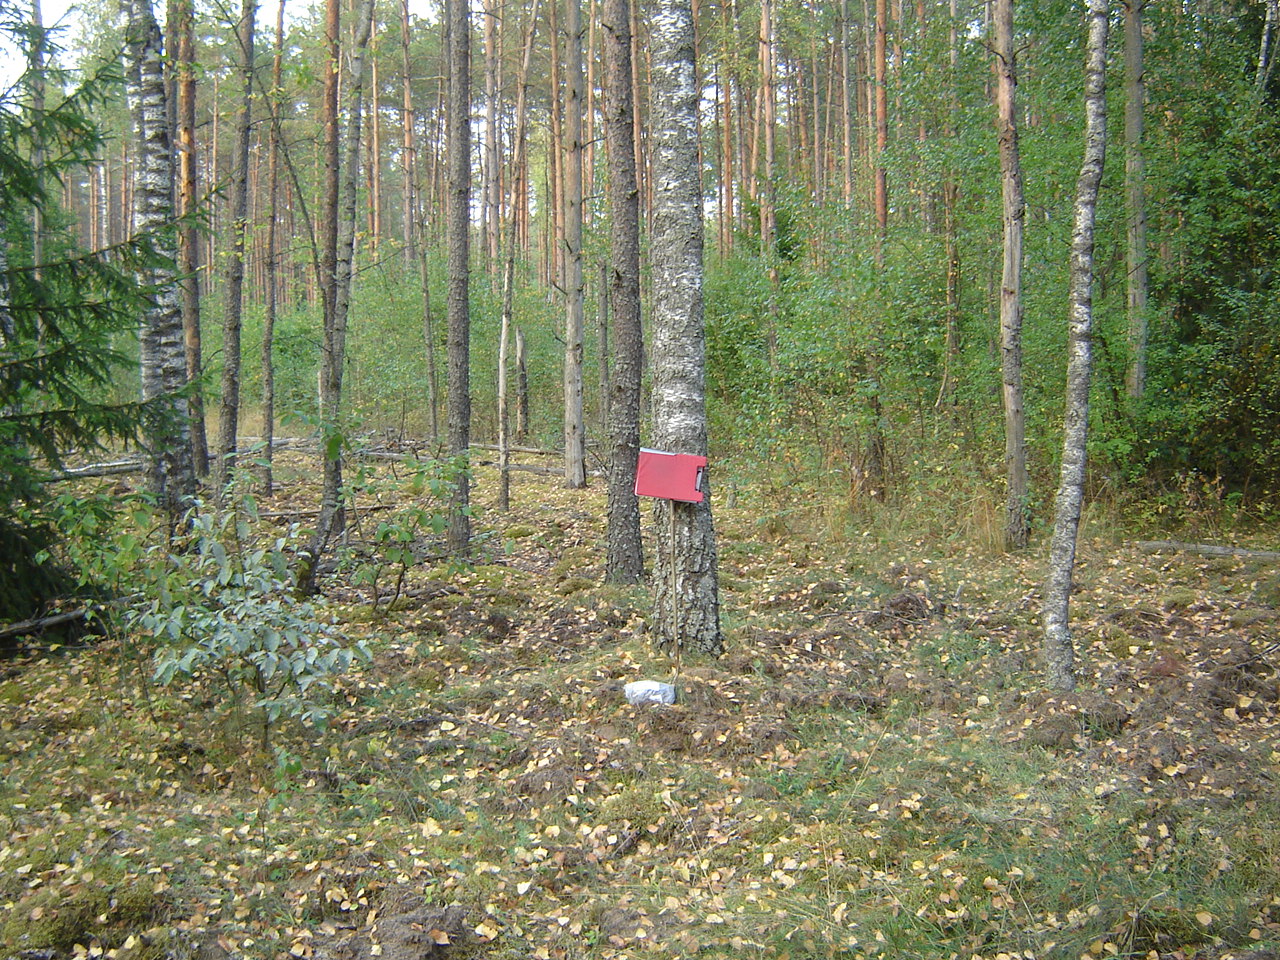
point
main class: Woodland
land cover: Pine dominated mixed woodland
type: hemiboreal forest and nemoral coniferous forest and mixed broadleaved-coniferous forest
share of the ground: > 75 %
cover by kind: coniferous forest trees 55 %, broadleaved forest trees 30 %, lichens and mosses 15 %
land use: Forestry
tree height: > 5 m
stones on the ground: < 10 %
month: September
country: LT
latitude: 54.4292
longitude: 24.7688
